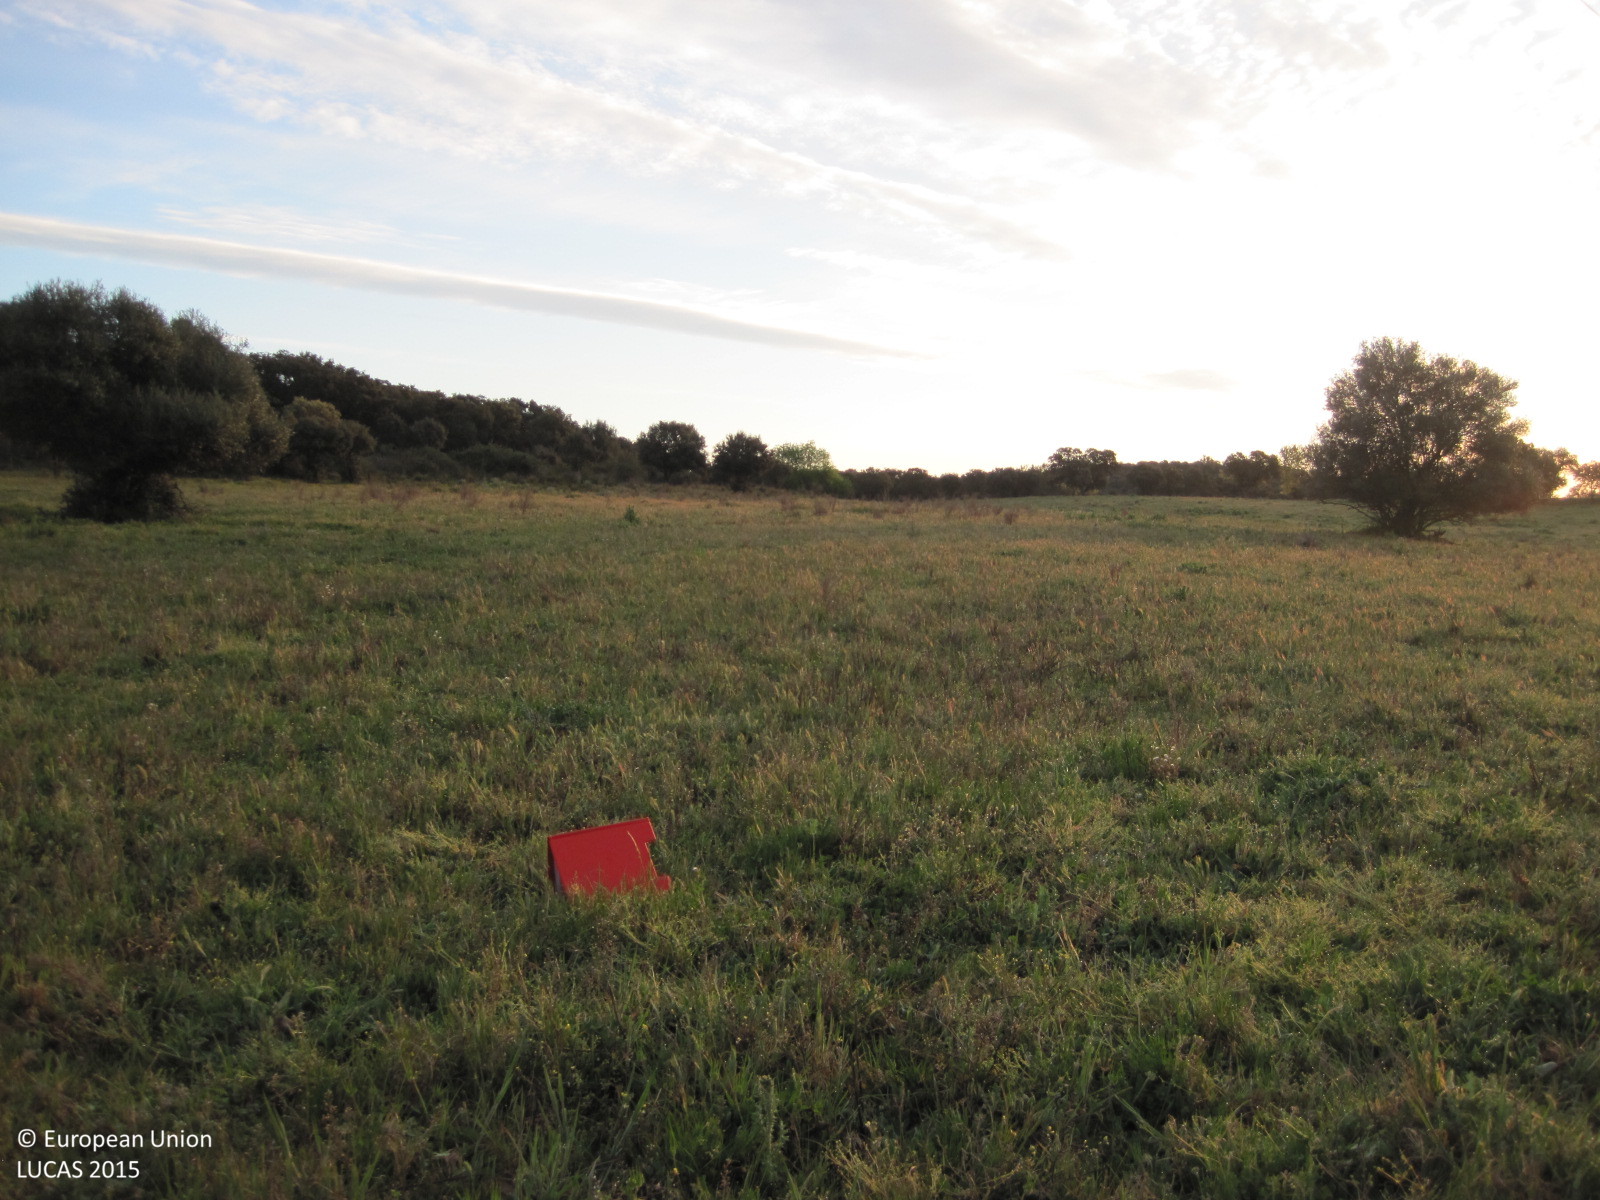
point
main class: Artificial land
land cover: Other artificial areas
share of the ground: < 10 %
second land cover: Spontaneously vegetated surfaces
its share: > 75 %
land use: Electricity, gas and thermal power distribution
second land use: Agriculture (excluding fallow land and kitchen gardens)
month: April
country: ES
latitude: 40.0085
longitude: -4.7492
